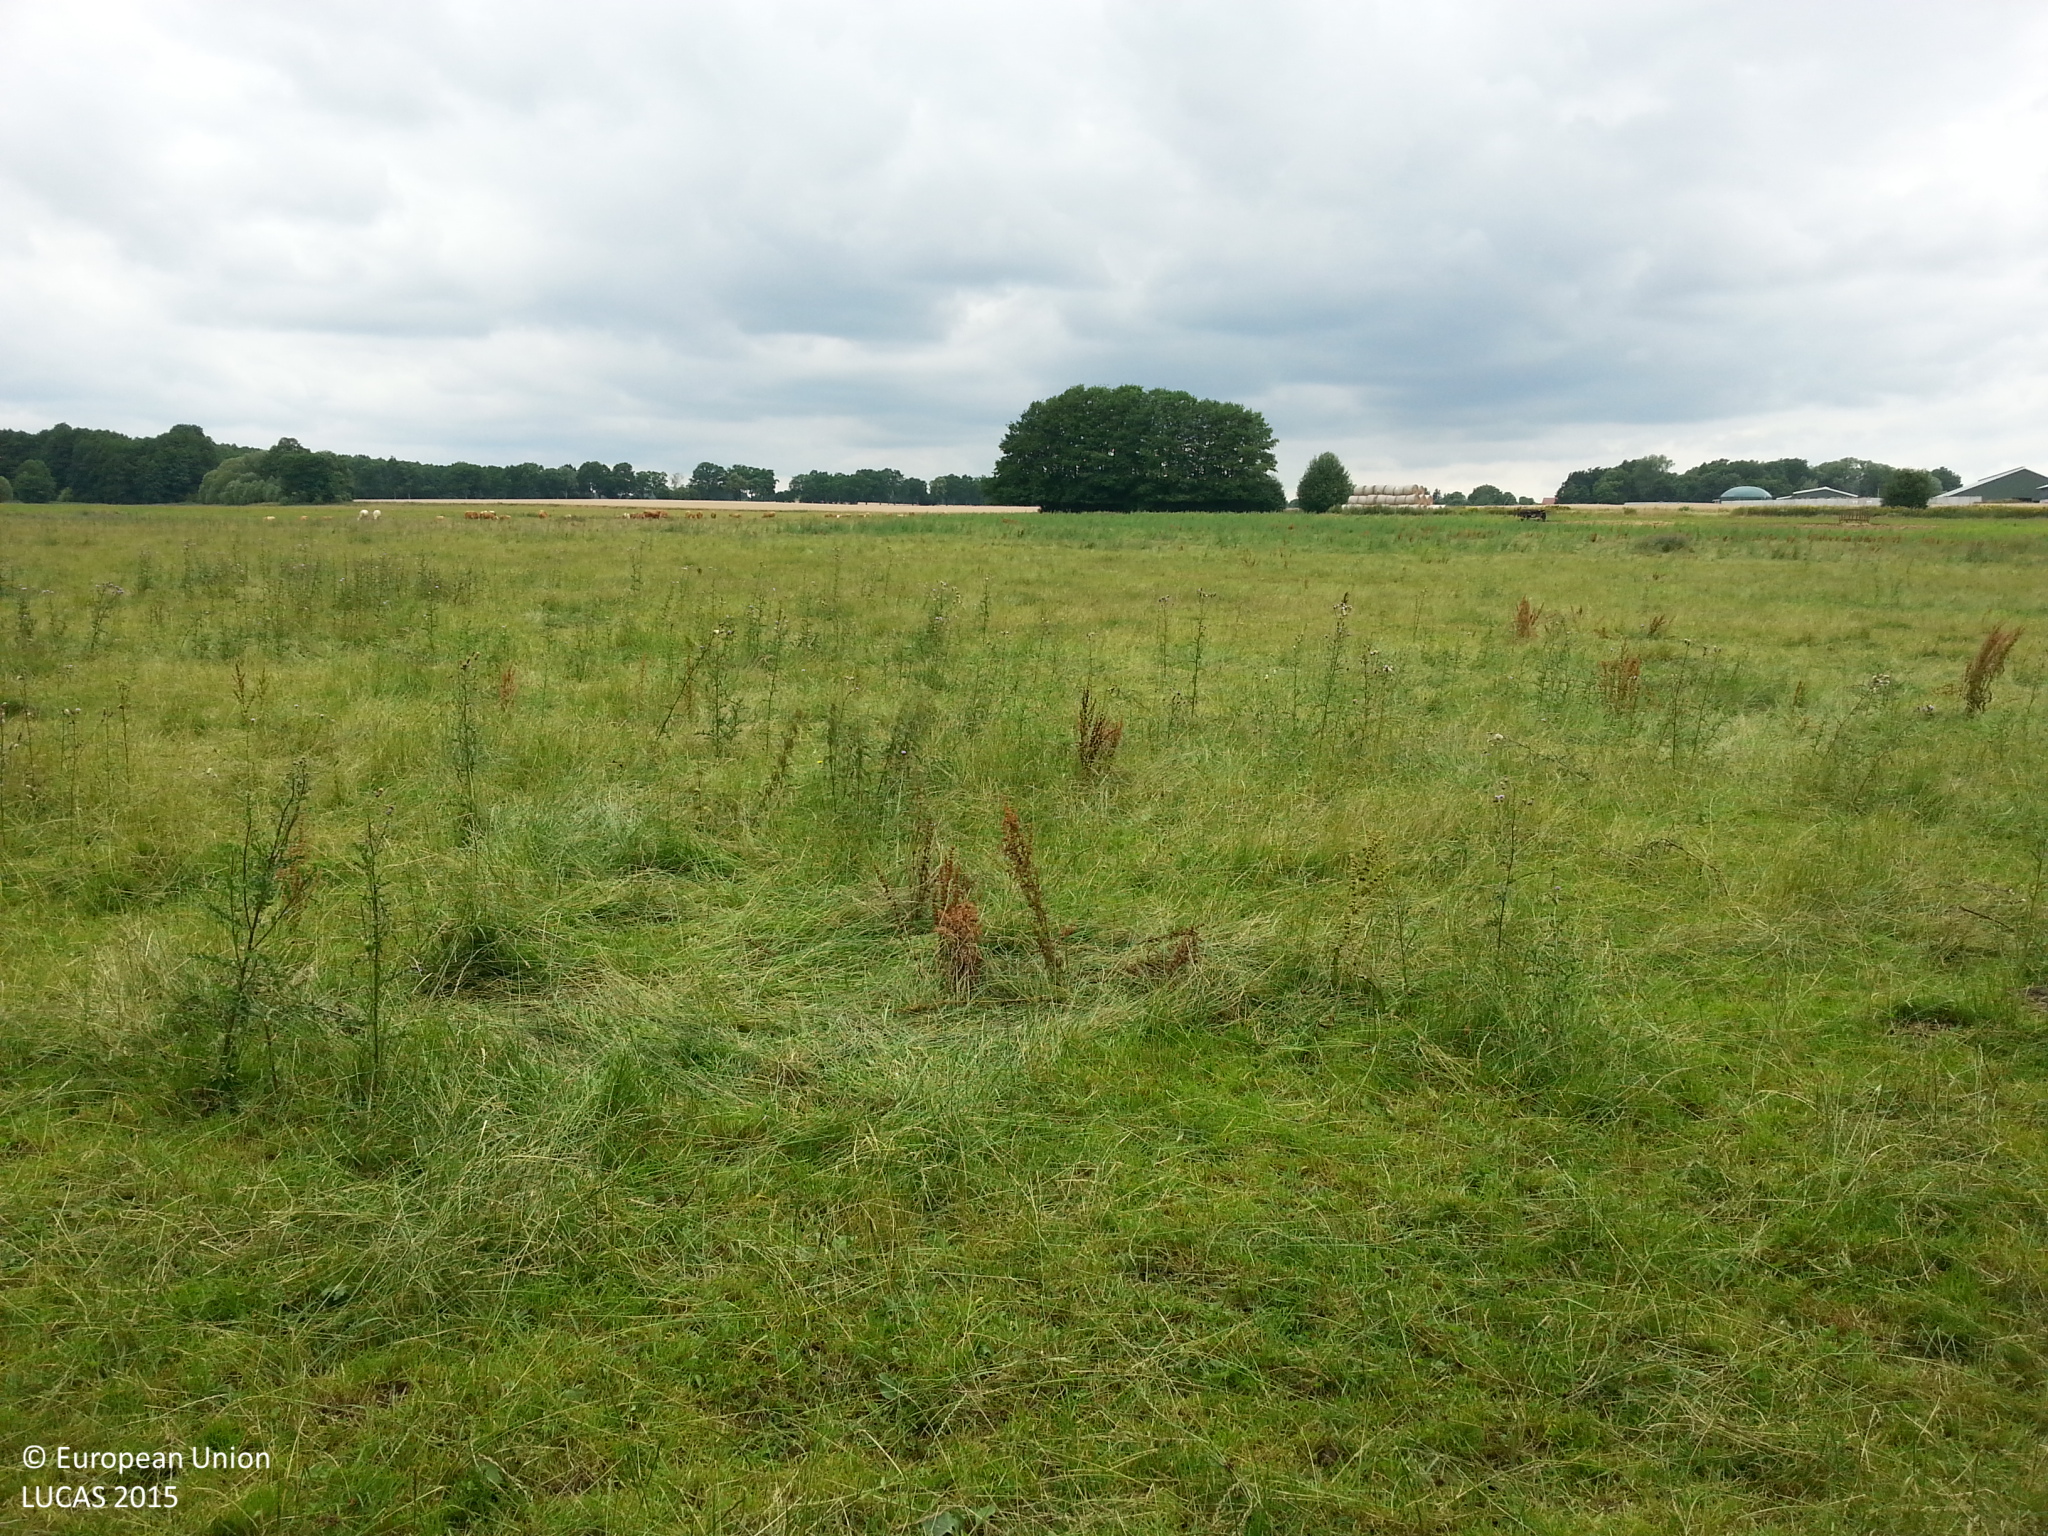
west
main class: Grassland
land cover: Grassland without tree/shrub cover
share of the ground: > 75 %
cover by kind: herbaceous plants 100 %
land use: Agriculture (excluding fallow land and kitchen gardens)
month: July
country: DE
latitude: 53.1994
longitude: 12.3496
